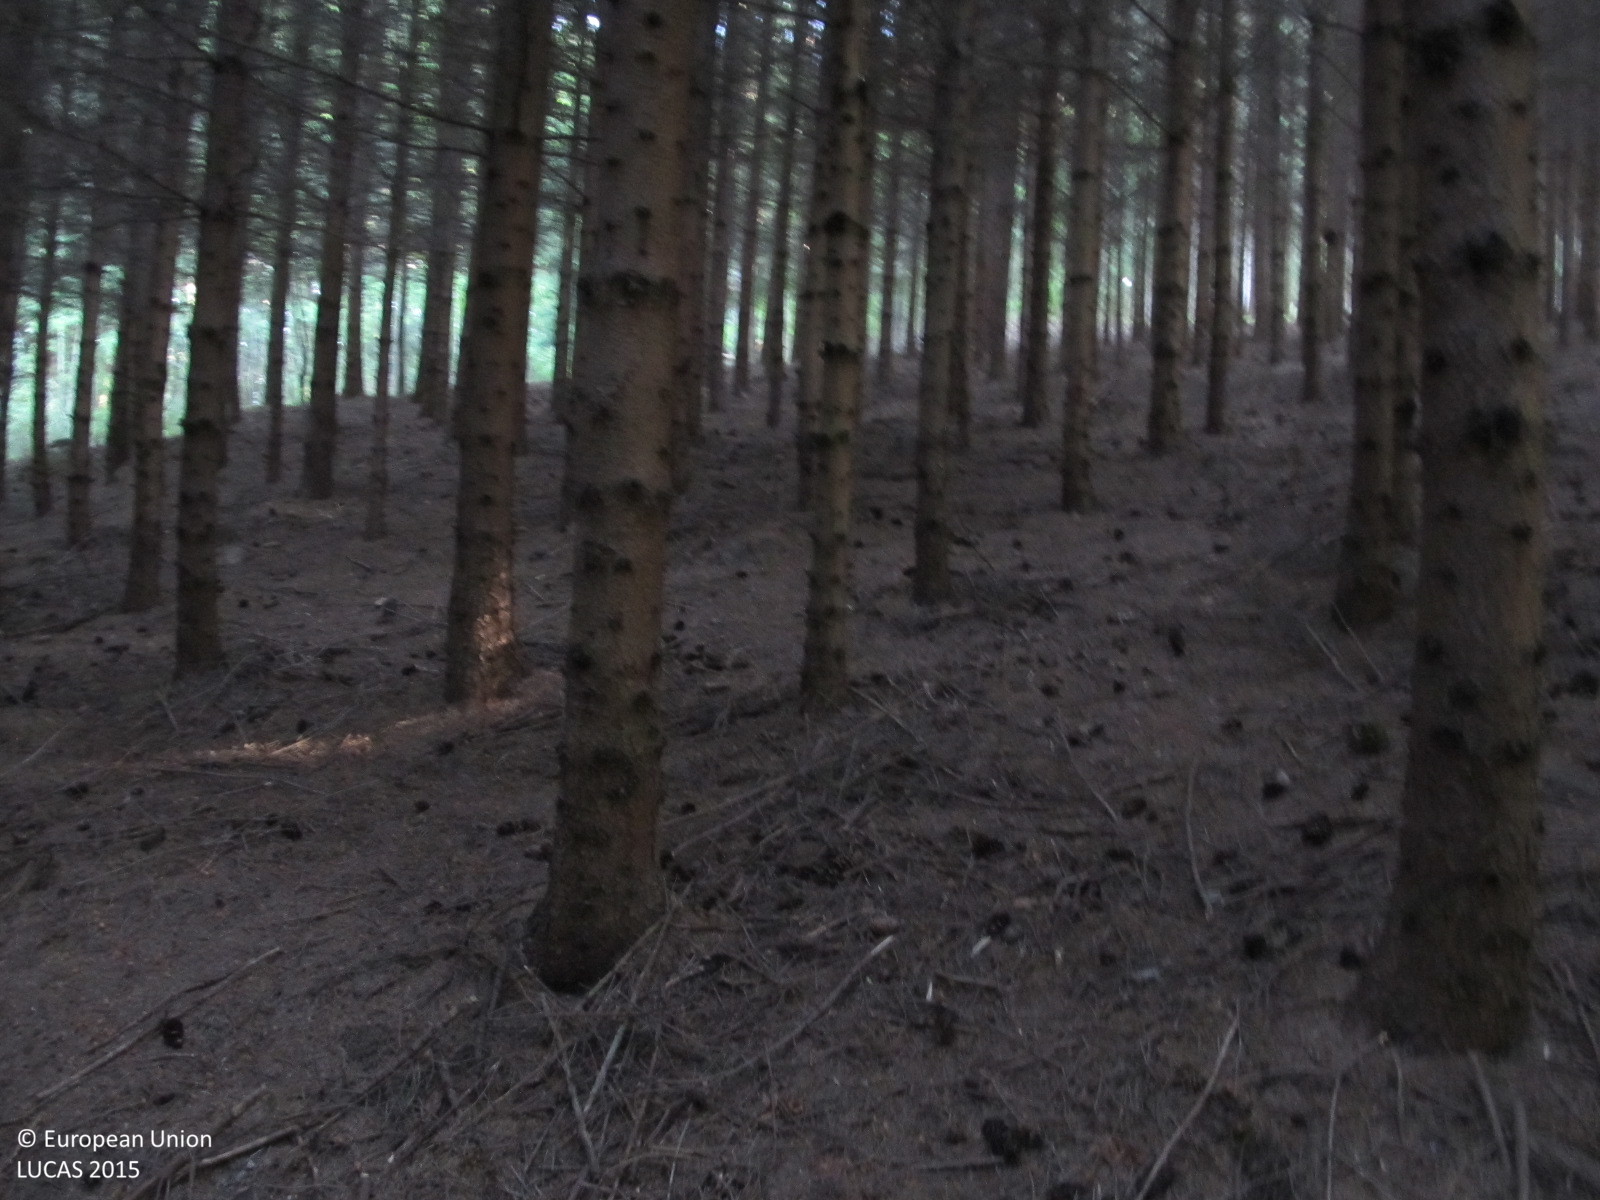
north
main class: Woodland
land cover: Spruce dominated coniferous woodland
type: hemiboreal forest and nemoral coniferous forest and mixed broadleaved-coniferous forest
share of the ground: > 75 %
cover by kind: coniferous forest trees 85 %, unconsolidated bare surface 15 %
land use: Forestry
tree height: > 5 m
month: June
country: AT
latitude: 48.5417
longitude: 15.4070
